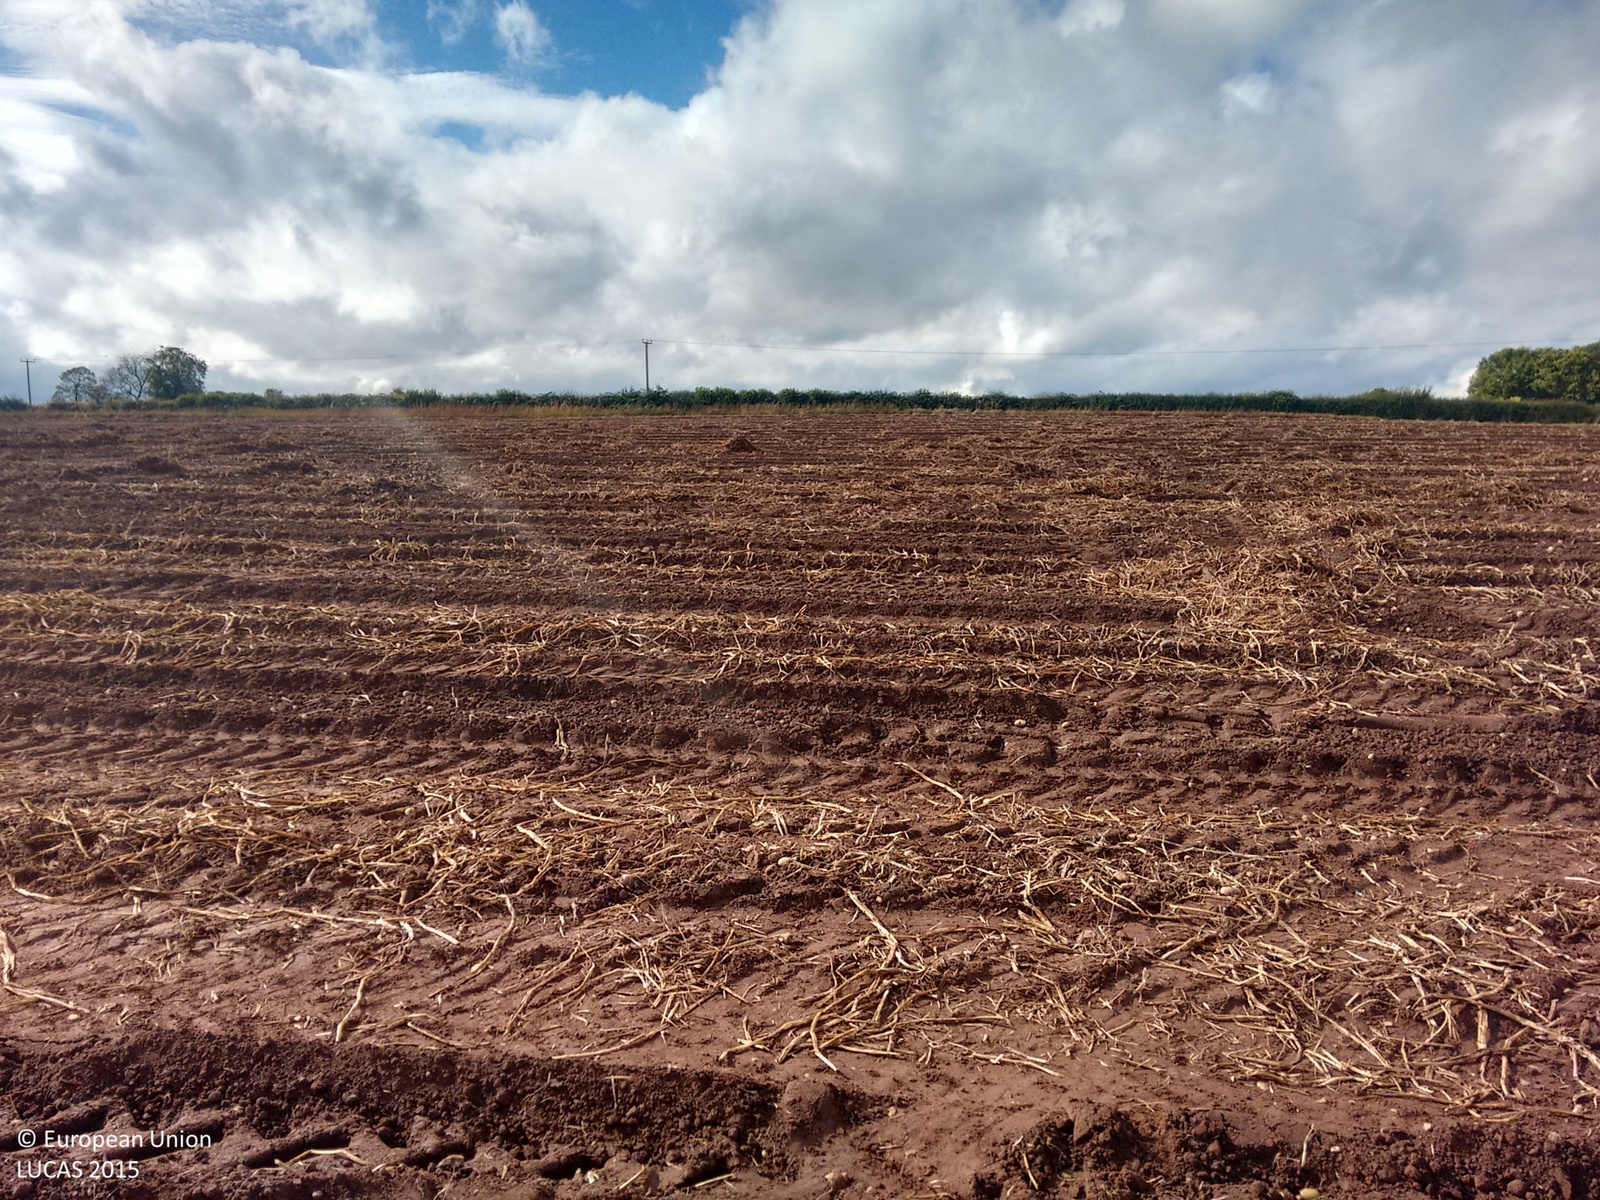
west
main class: Cropland
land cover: Potatoes
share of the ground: < 10 %
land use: Agriculture (excluding fallow land and kitchen gardens)
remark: Harvested field
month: October
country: GB
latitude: 52.7107
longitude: -2.3642
